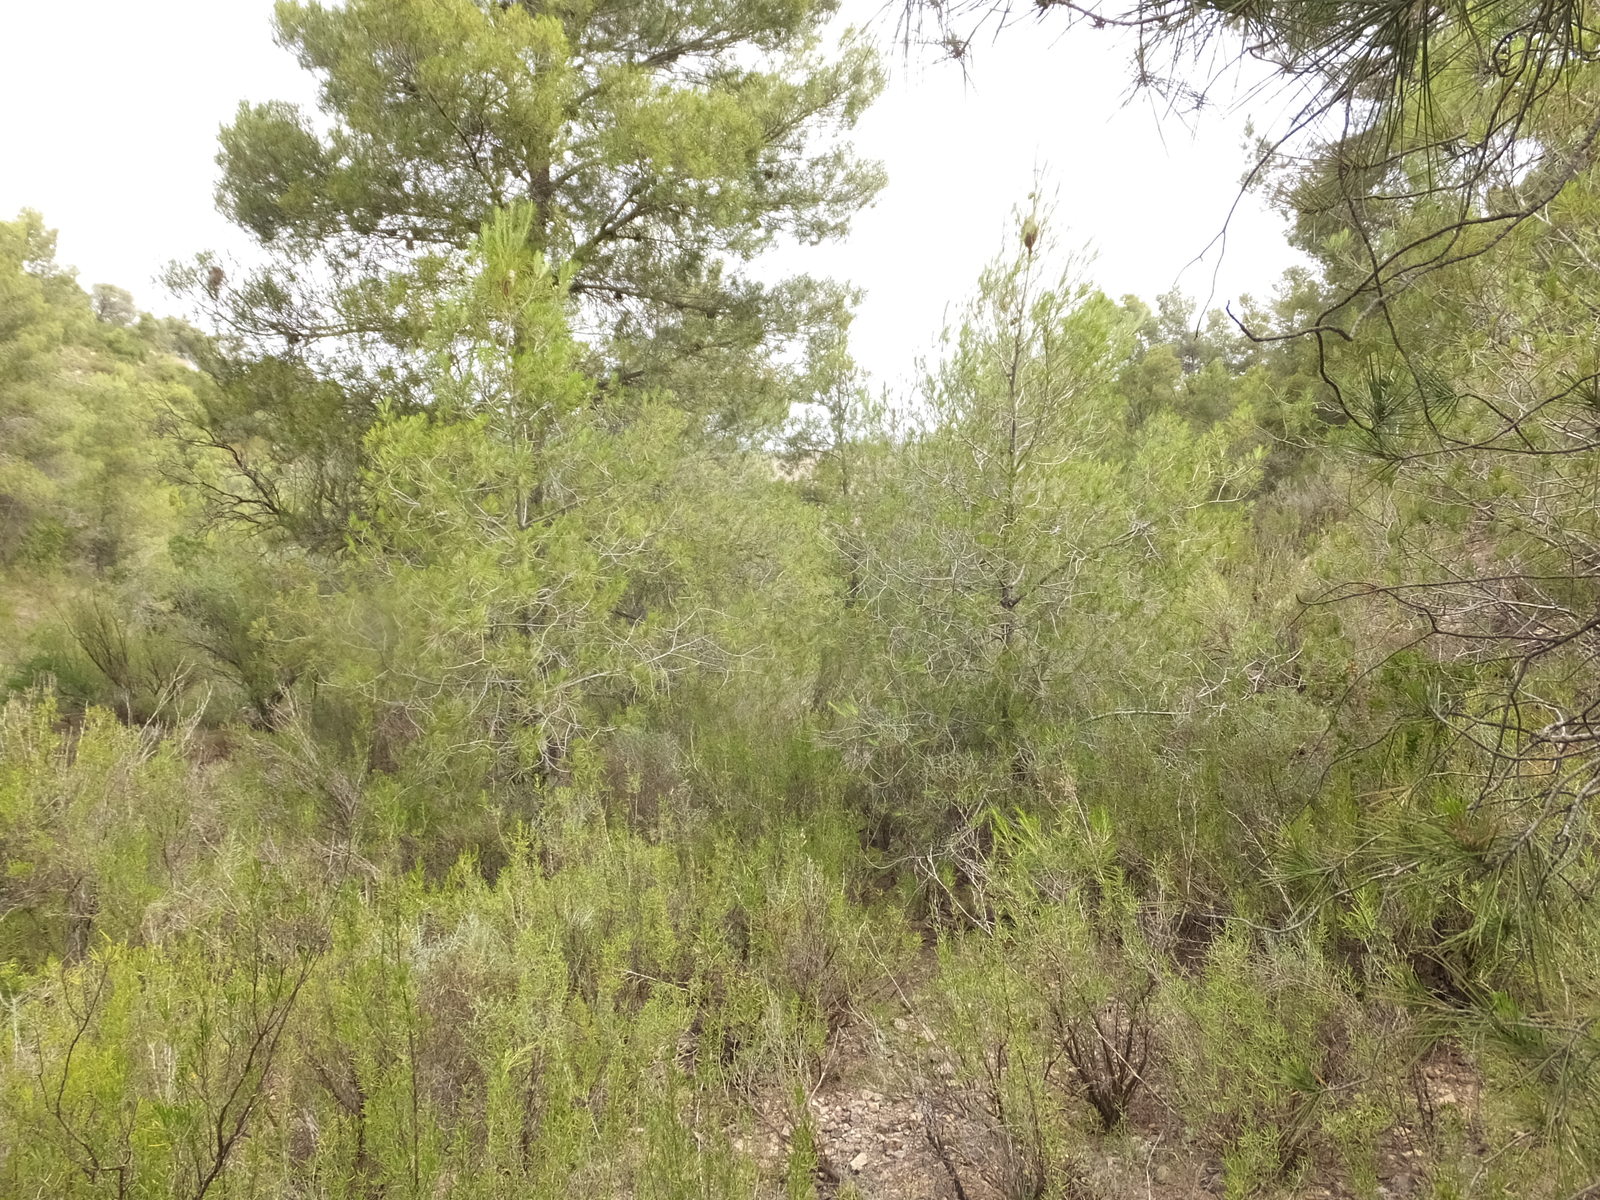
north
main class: Woodland
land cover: Pine dominated mixed woodland
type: coniferous forest of the mediterranean region
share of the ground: 50 - 75 %
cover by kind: coniferous forest trees 60 %, broadleaved forest trees 20 %, shrubs 20 %
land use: Forestry
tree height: > 5 m
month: July
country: ES
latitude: 41.3730
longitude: 0.3397
